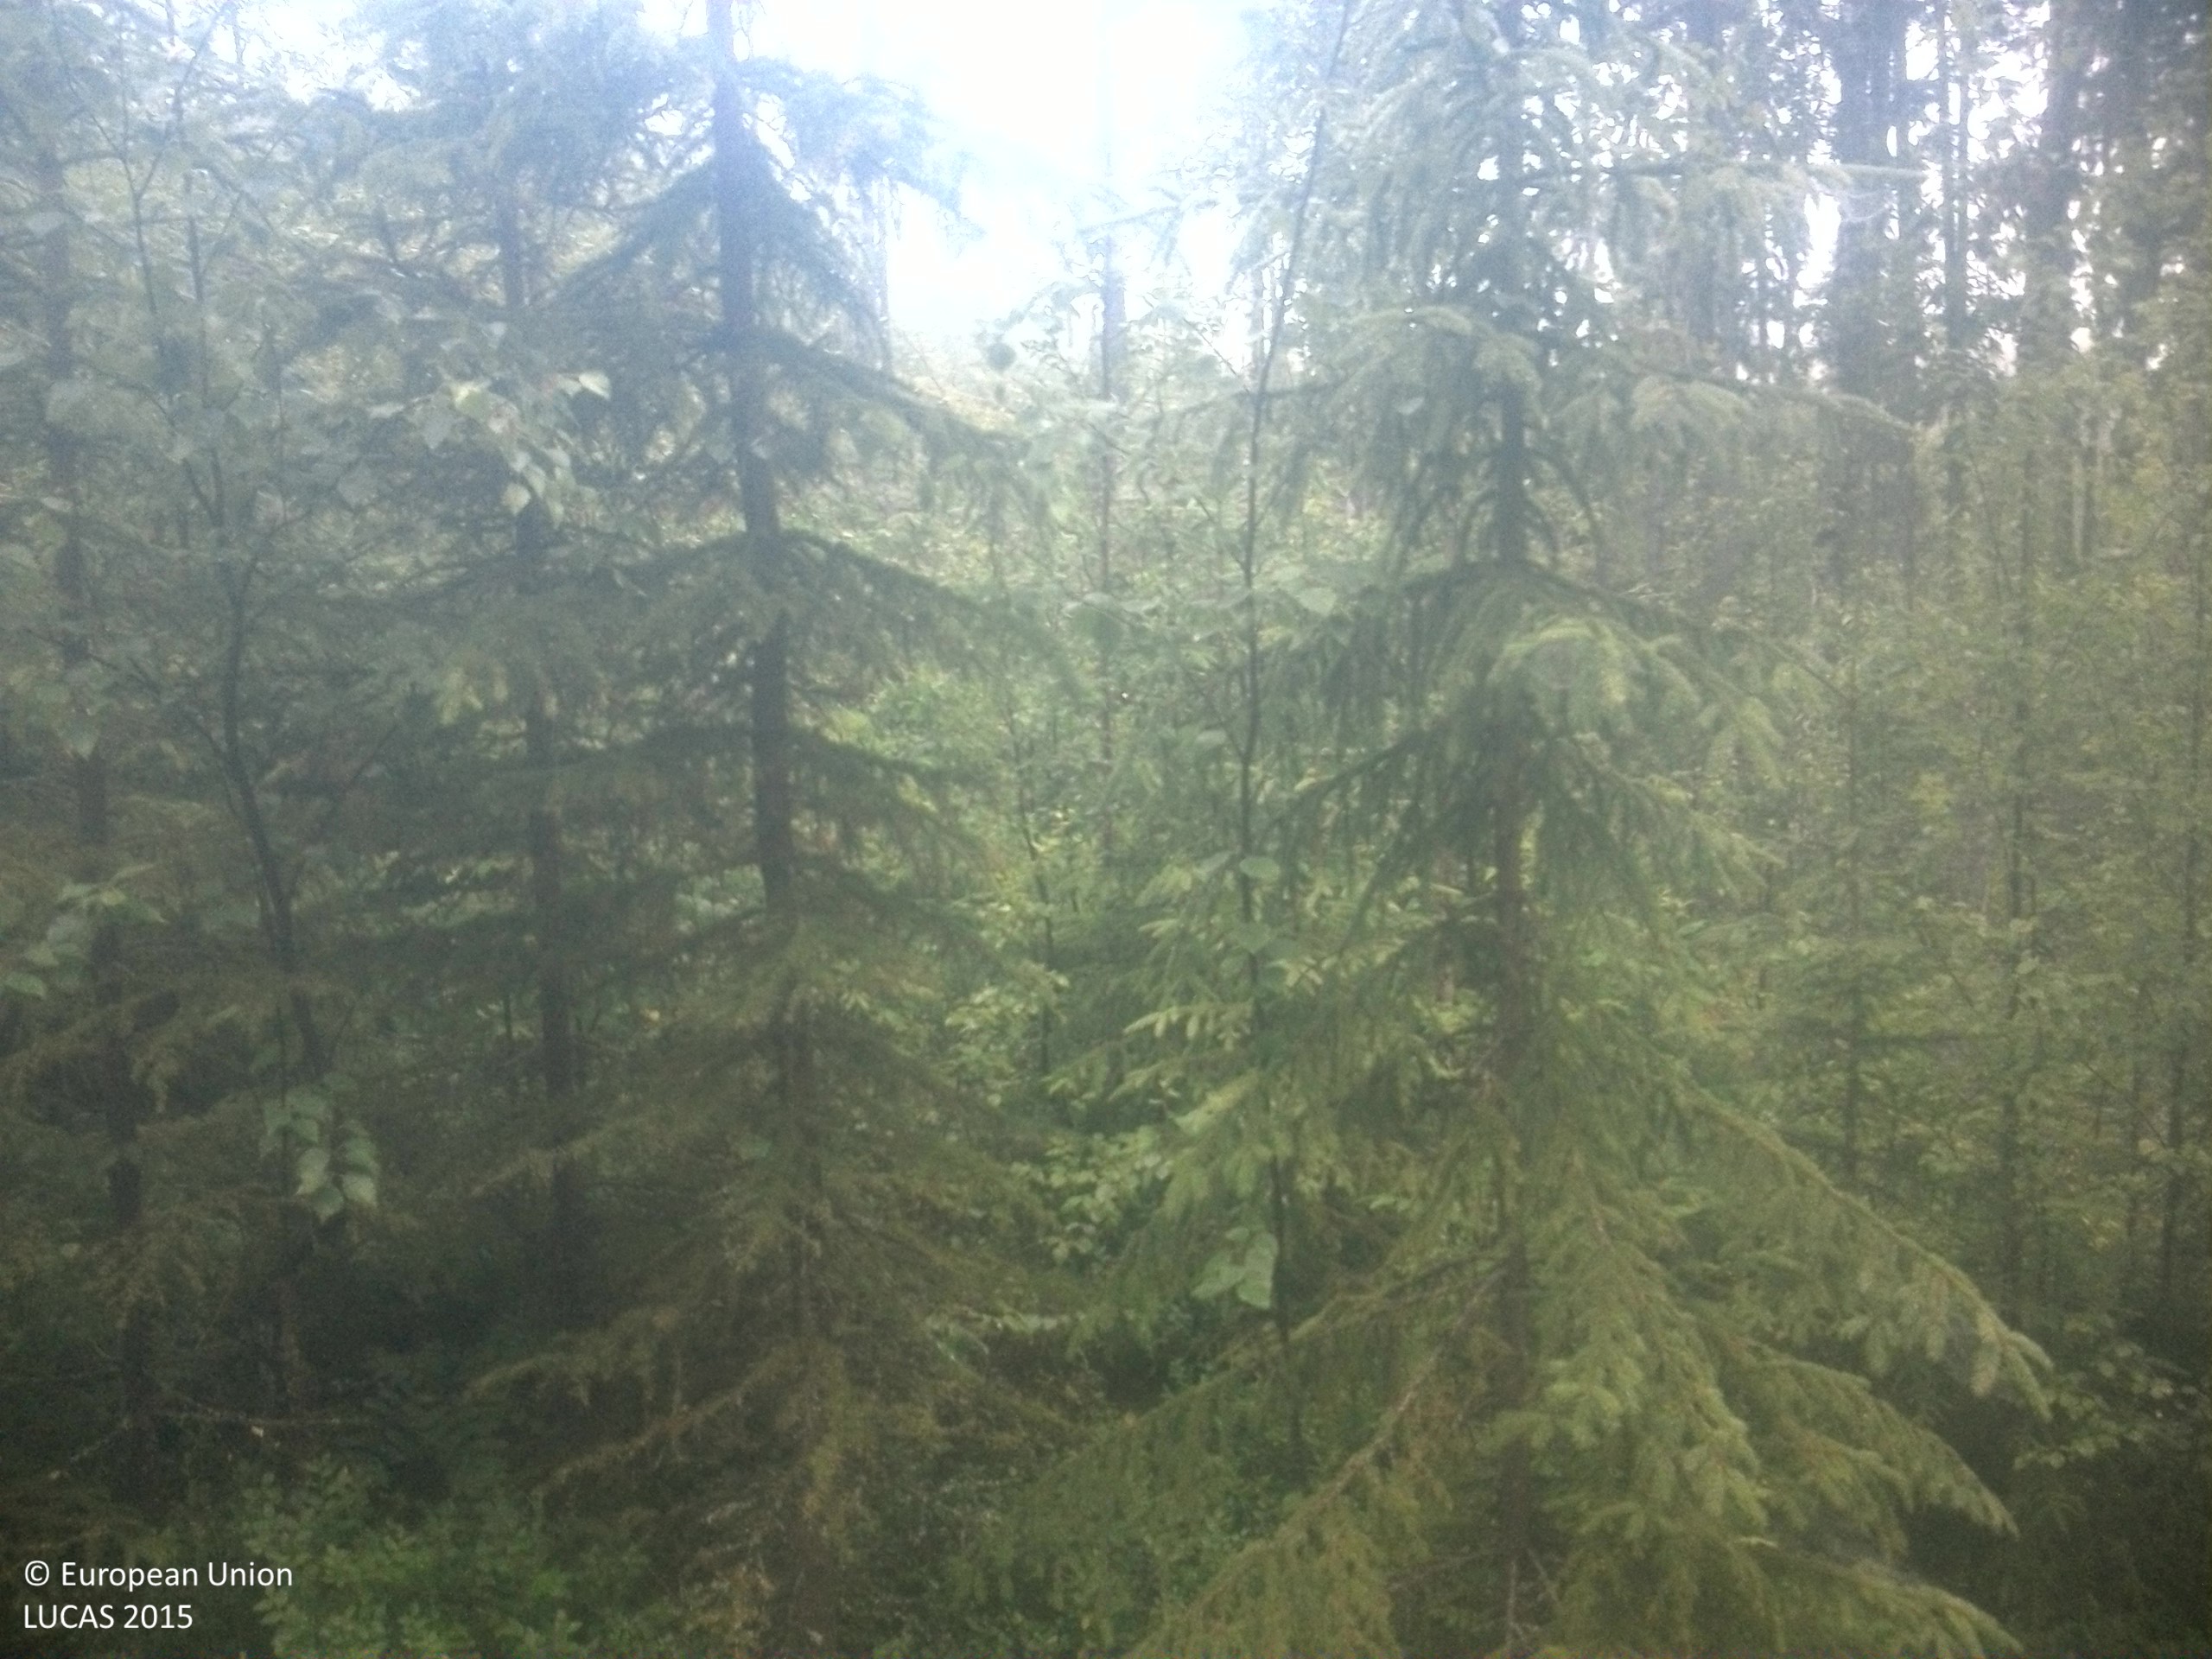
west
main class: Woodland
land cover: Spruce dominated mixed woodland
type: boreal forest
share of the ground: 50 - 75 %
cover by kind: coniferous forest trees 45 %, shrubs 20 %, broadleaved forest trees 15 %, lichens and mosses 10 %, herbaceous plants 5 %, consolidated bare surface 5 %
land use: Forestry
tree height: > 5 m
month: August
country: SE
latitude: 63.5431
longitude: 16.4315
